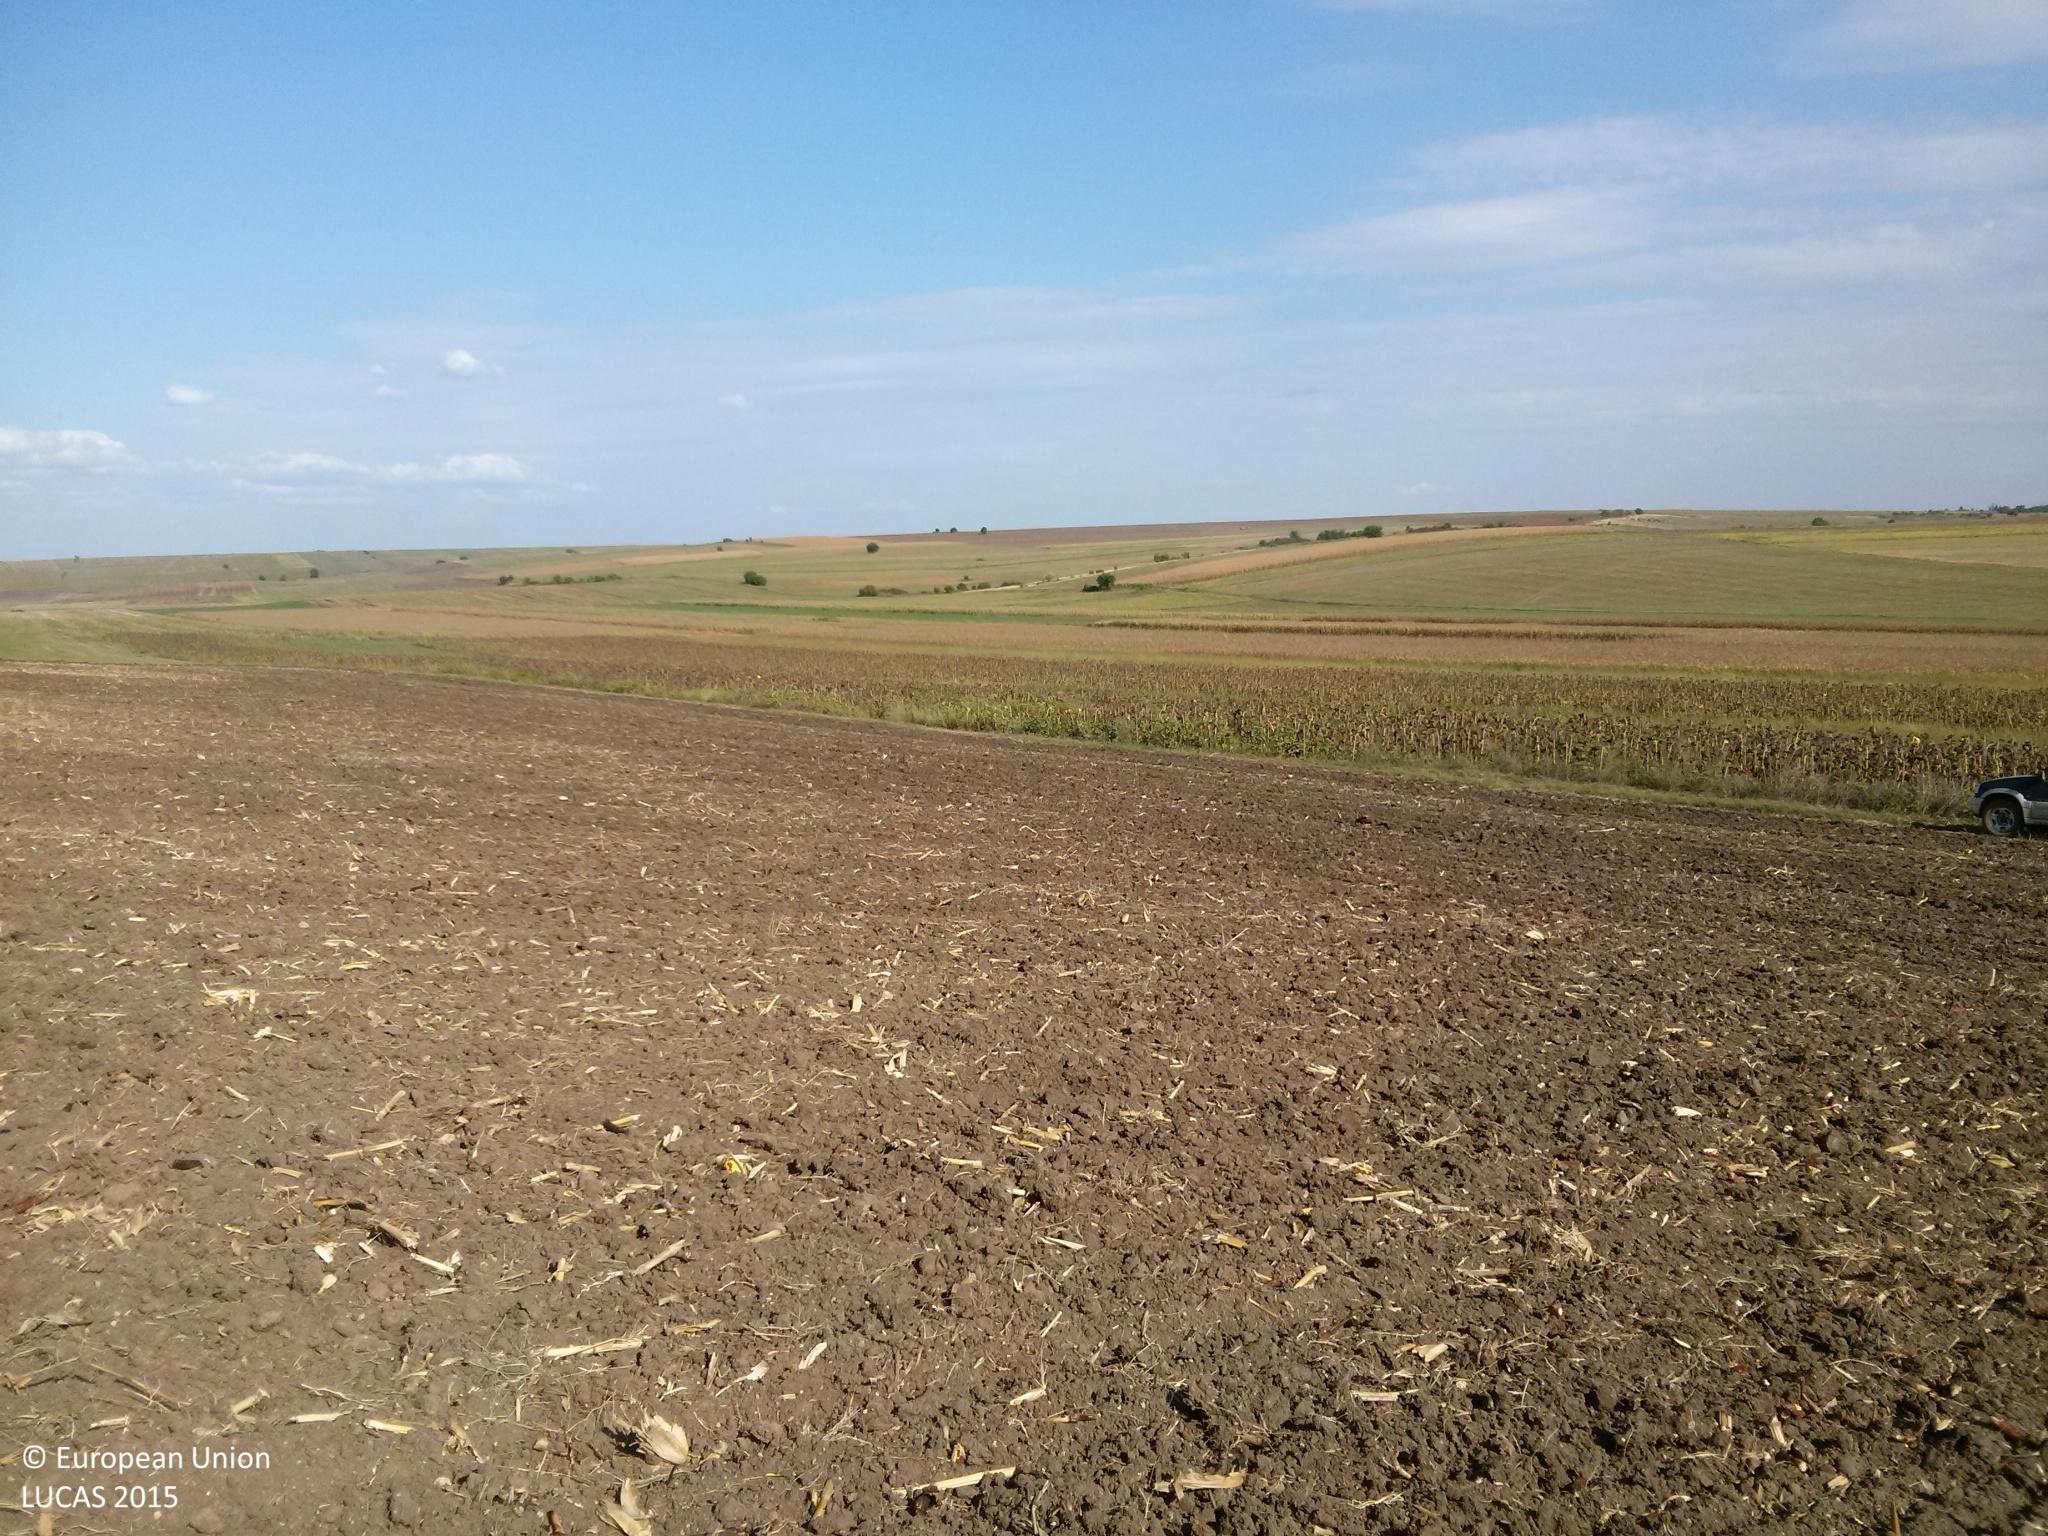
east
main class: Cropland
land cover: Maize
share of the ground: < 10 %
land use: Agriculture (excluding fallow land and kitchen gardens)
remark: Harvested field
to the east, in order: Maize; Grass margins; Tracks; Grass margins; Sunflower; Grass margins; Common wheat; Grass margins; Sunflower
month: September
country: BG
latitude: 43.9038
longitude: 26.4815
